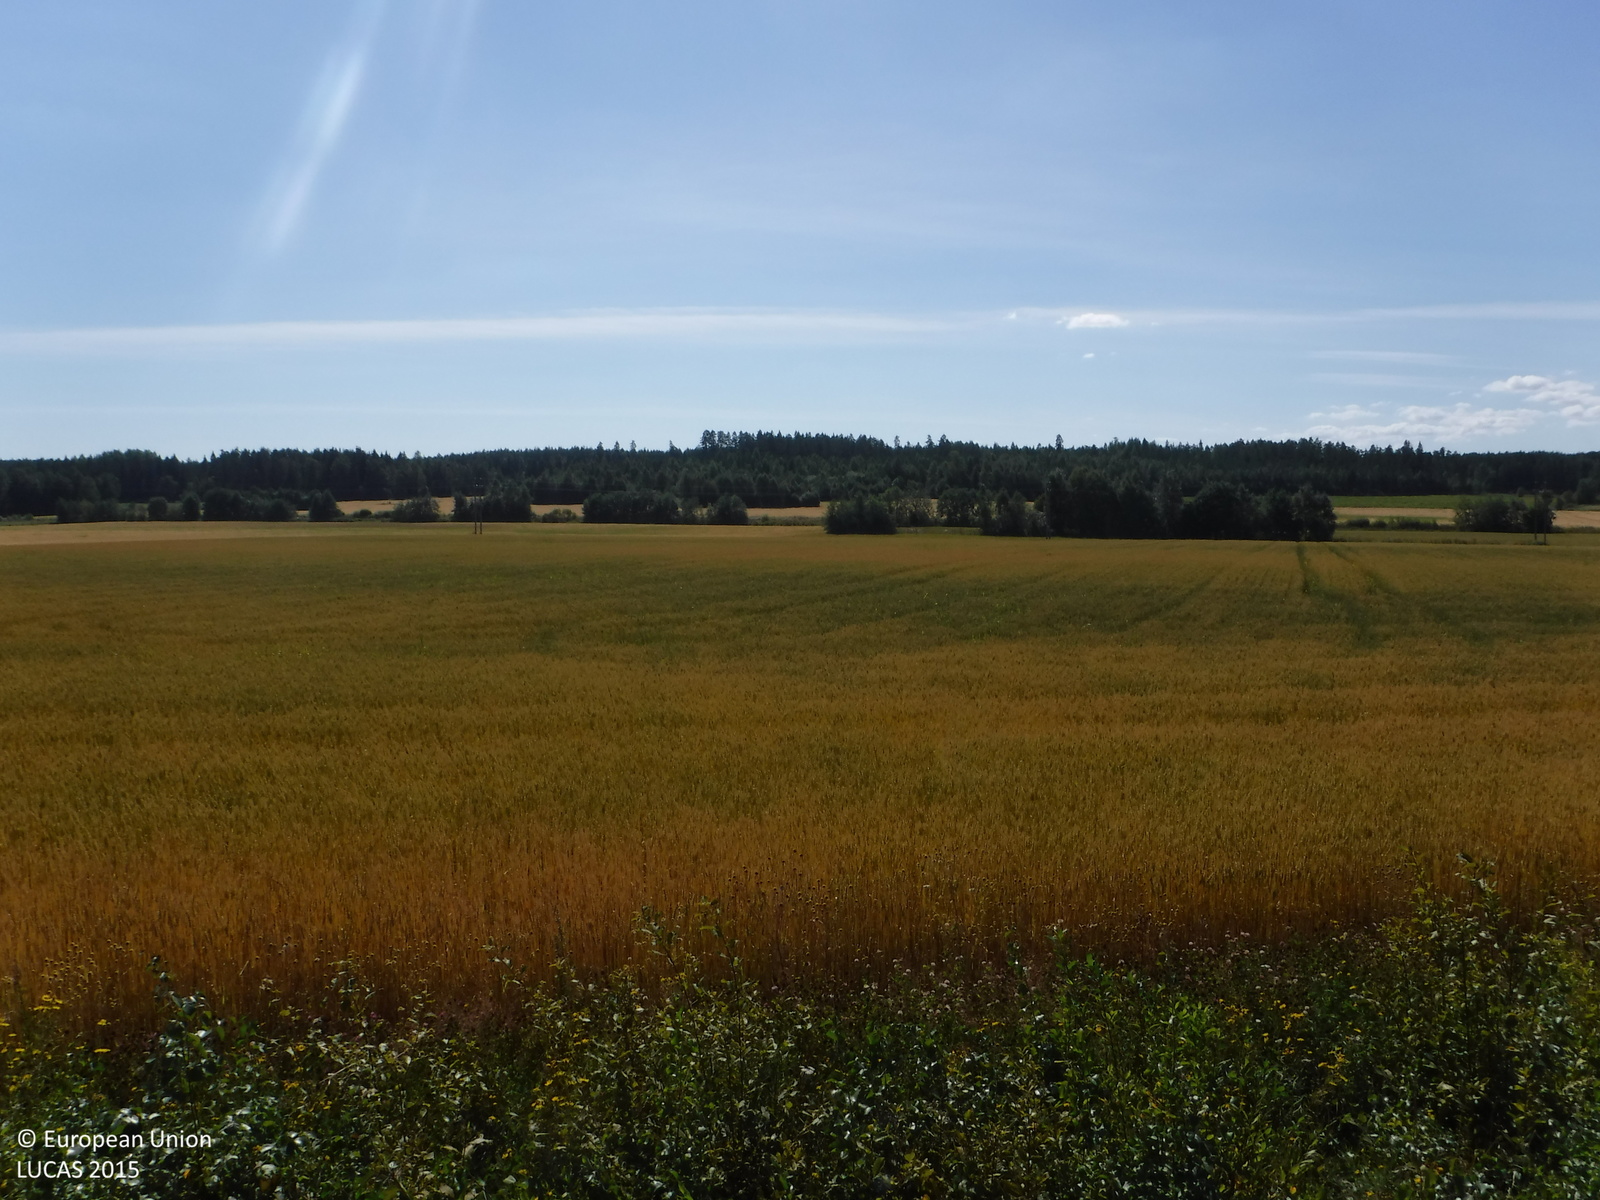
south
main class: Cropland
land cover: Common wheat
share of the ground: > 75 %
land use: Agriculture (excluding fallow land and kitchen gardens)
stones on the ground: < 10 %
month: August
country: FI
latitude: 61.1000
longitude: 21.8734
